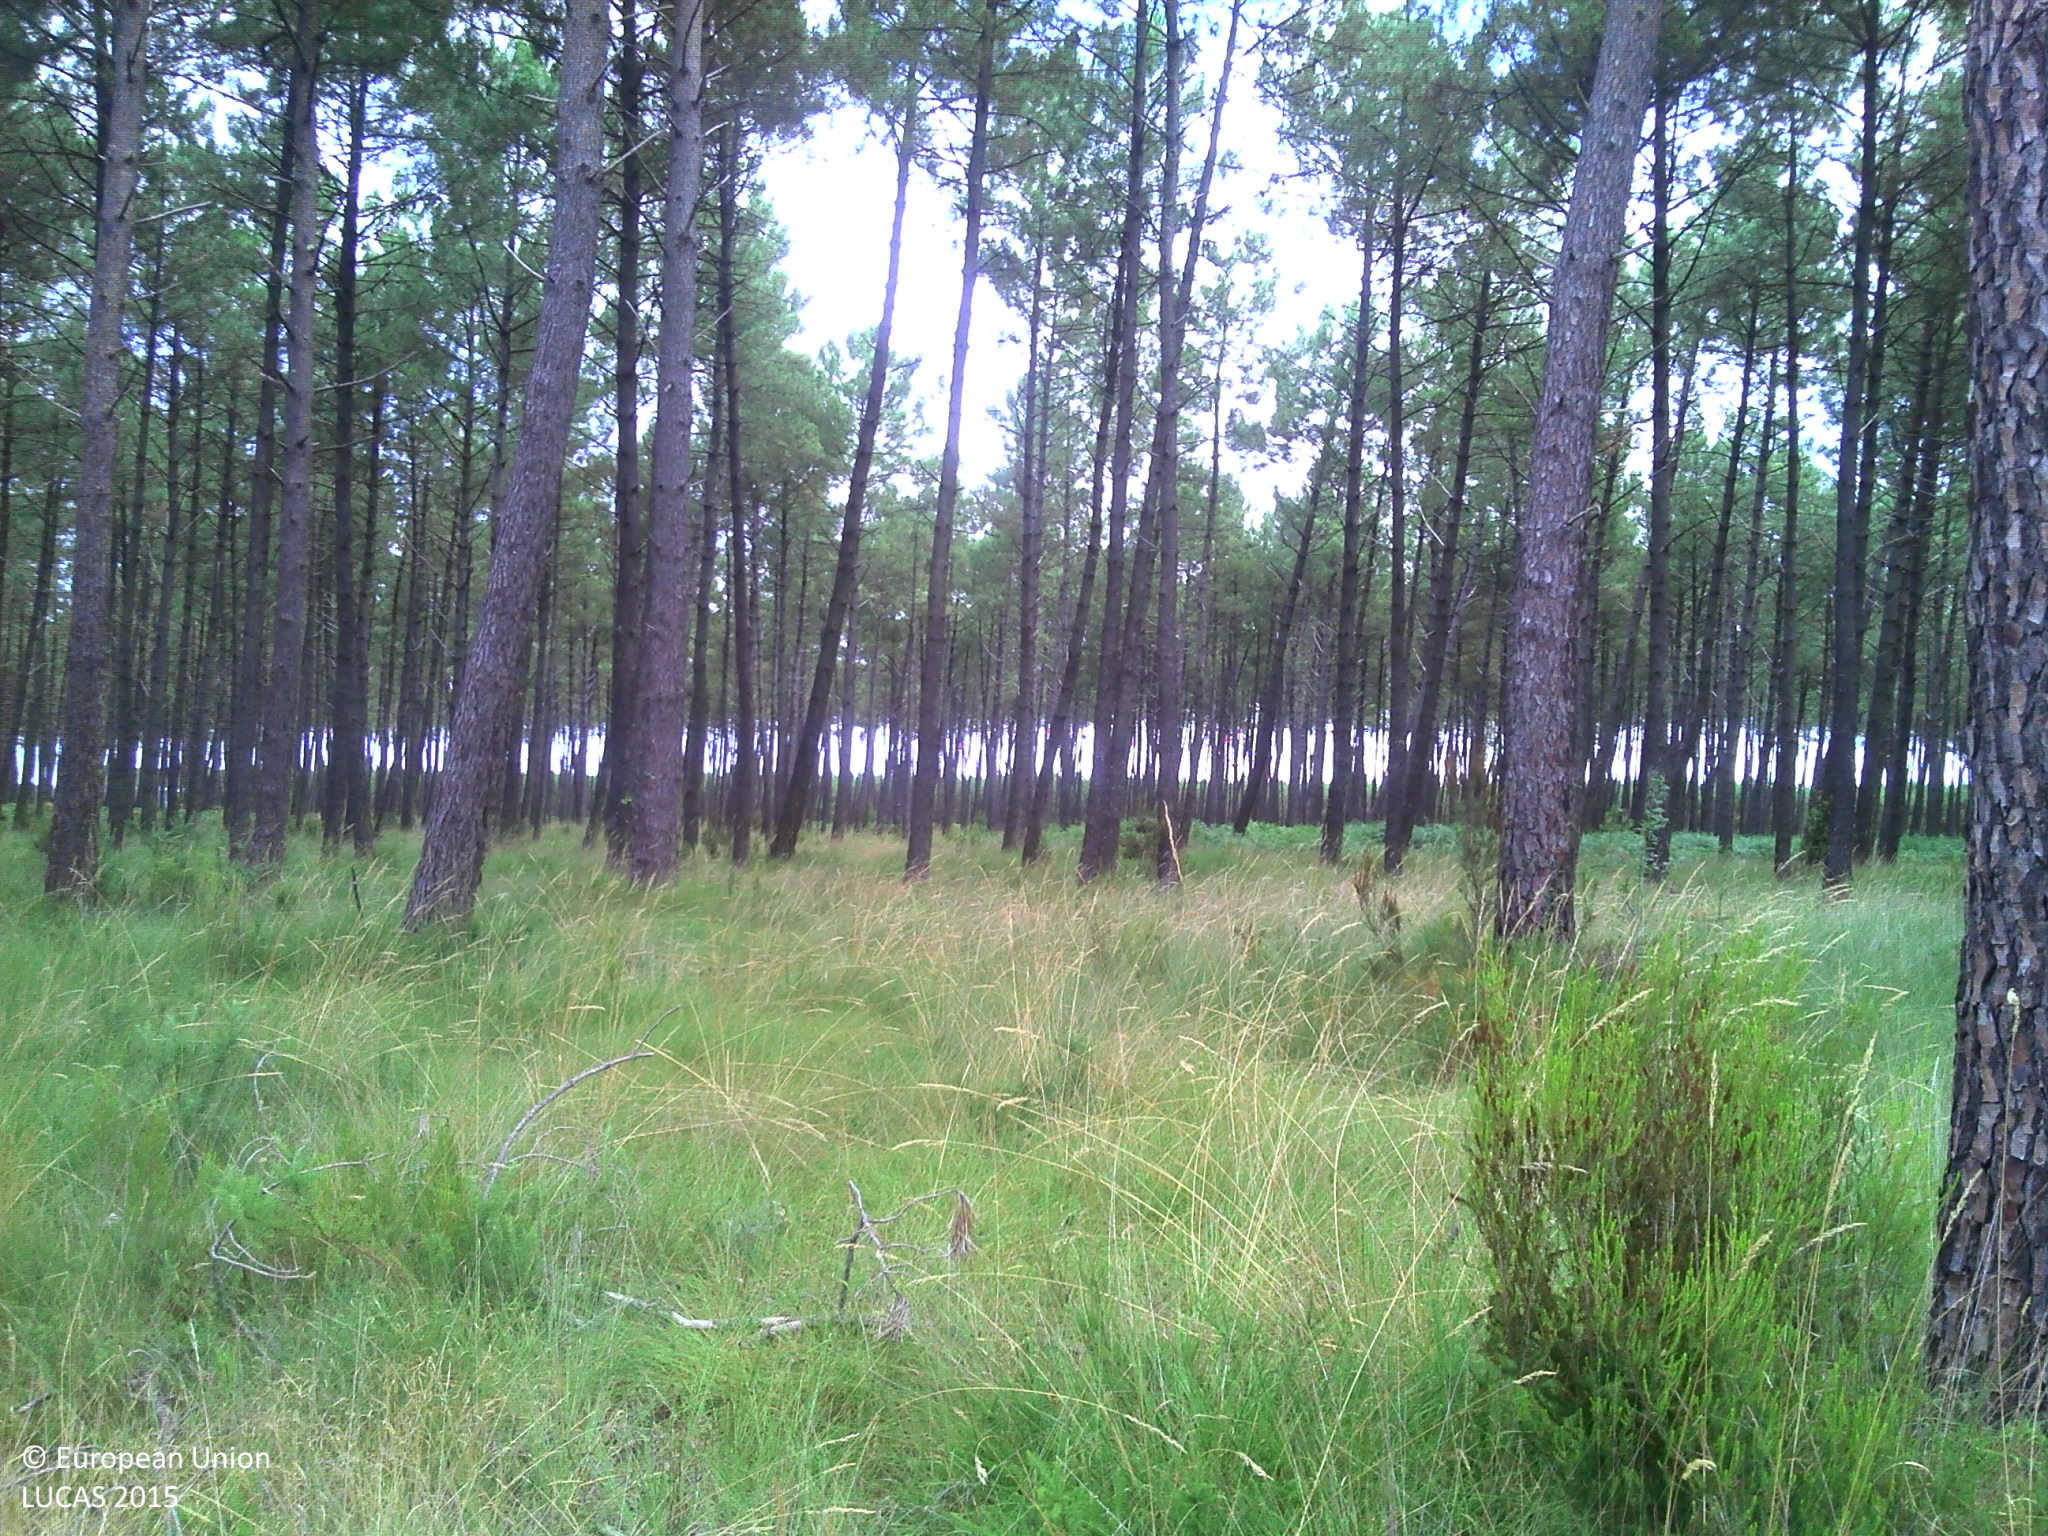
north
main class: Artificial land
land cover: Non built-up linear features
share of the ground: > 75 %
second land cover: Grassland without tree/shrub cover
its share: 50 - 75 %
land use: Road transport
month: July
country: FR
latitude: 44.1238
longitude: -1.2048
